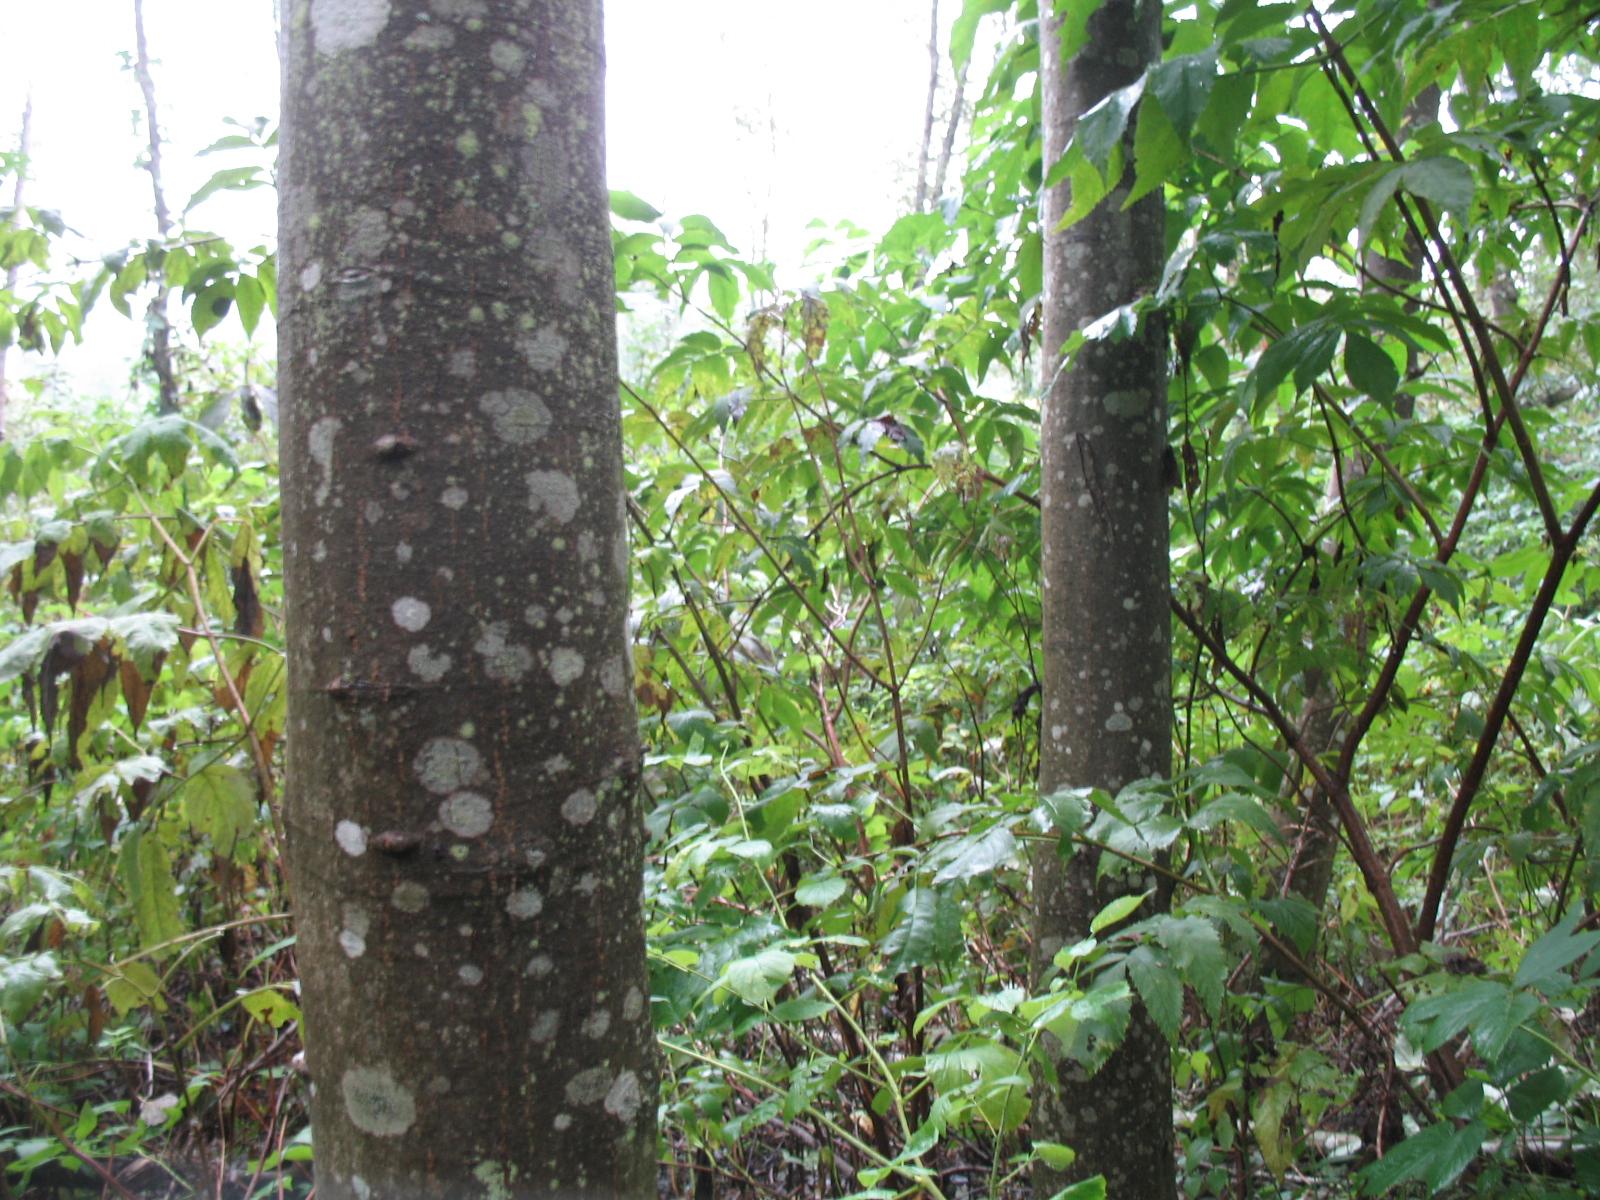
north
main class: Woodland
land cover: Broadleaved woodland
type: non-riverine alder, birch or aspen forest
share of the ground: > 75 %
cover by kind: broadleaved forest trees 75 %, shrubs 20 %, herbaceous plants 5 %
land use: Forestry
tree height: > 5 m
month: September
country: LV
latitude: 56.0903
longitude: 26.1641
